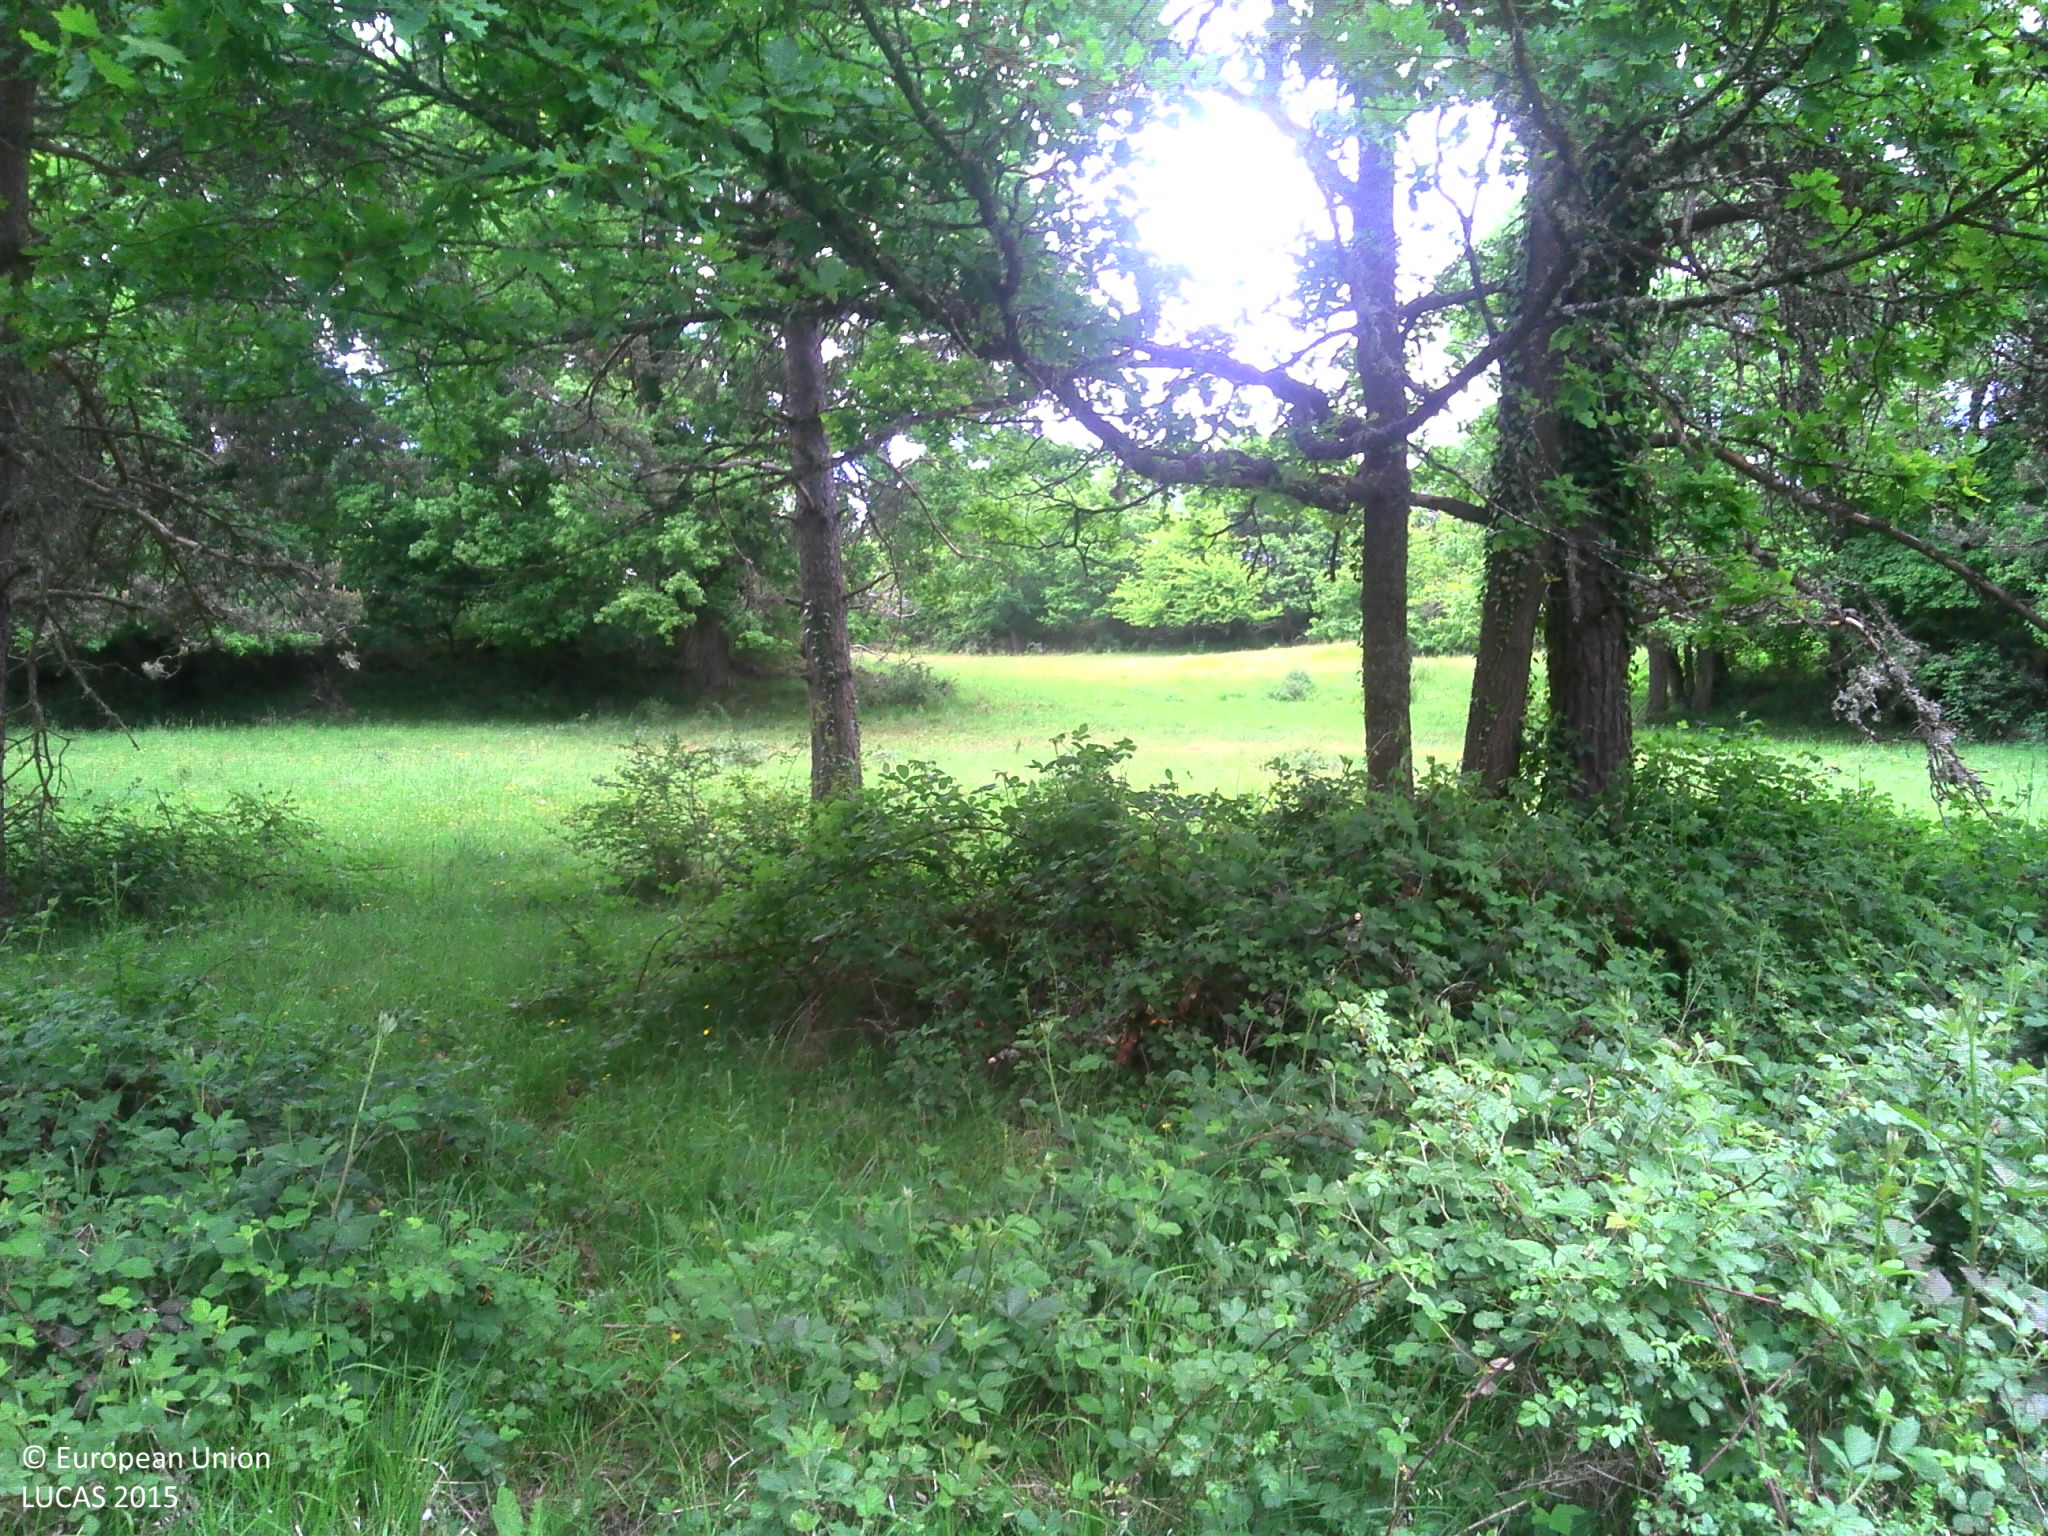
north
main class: Woodland
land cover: Pine dominated mixed woodland
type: alpine coniferous forest
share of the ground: 50 - 75 %
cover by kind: coniferous forest trees 50 %, broadleaved forest trees 20 %, herbaceous plants 20 %, shrubs 10 %
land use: Forestry
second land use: Agriculture (excluding fallow land and kitchen gardens)
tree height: > 5 m
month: June
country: FR
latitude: 45.0457
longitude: 3.1338
